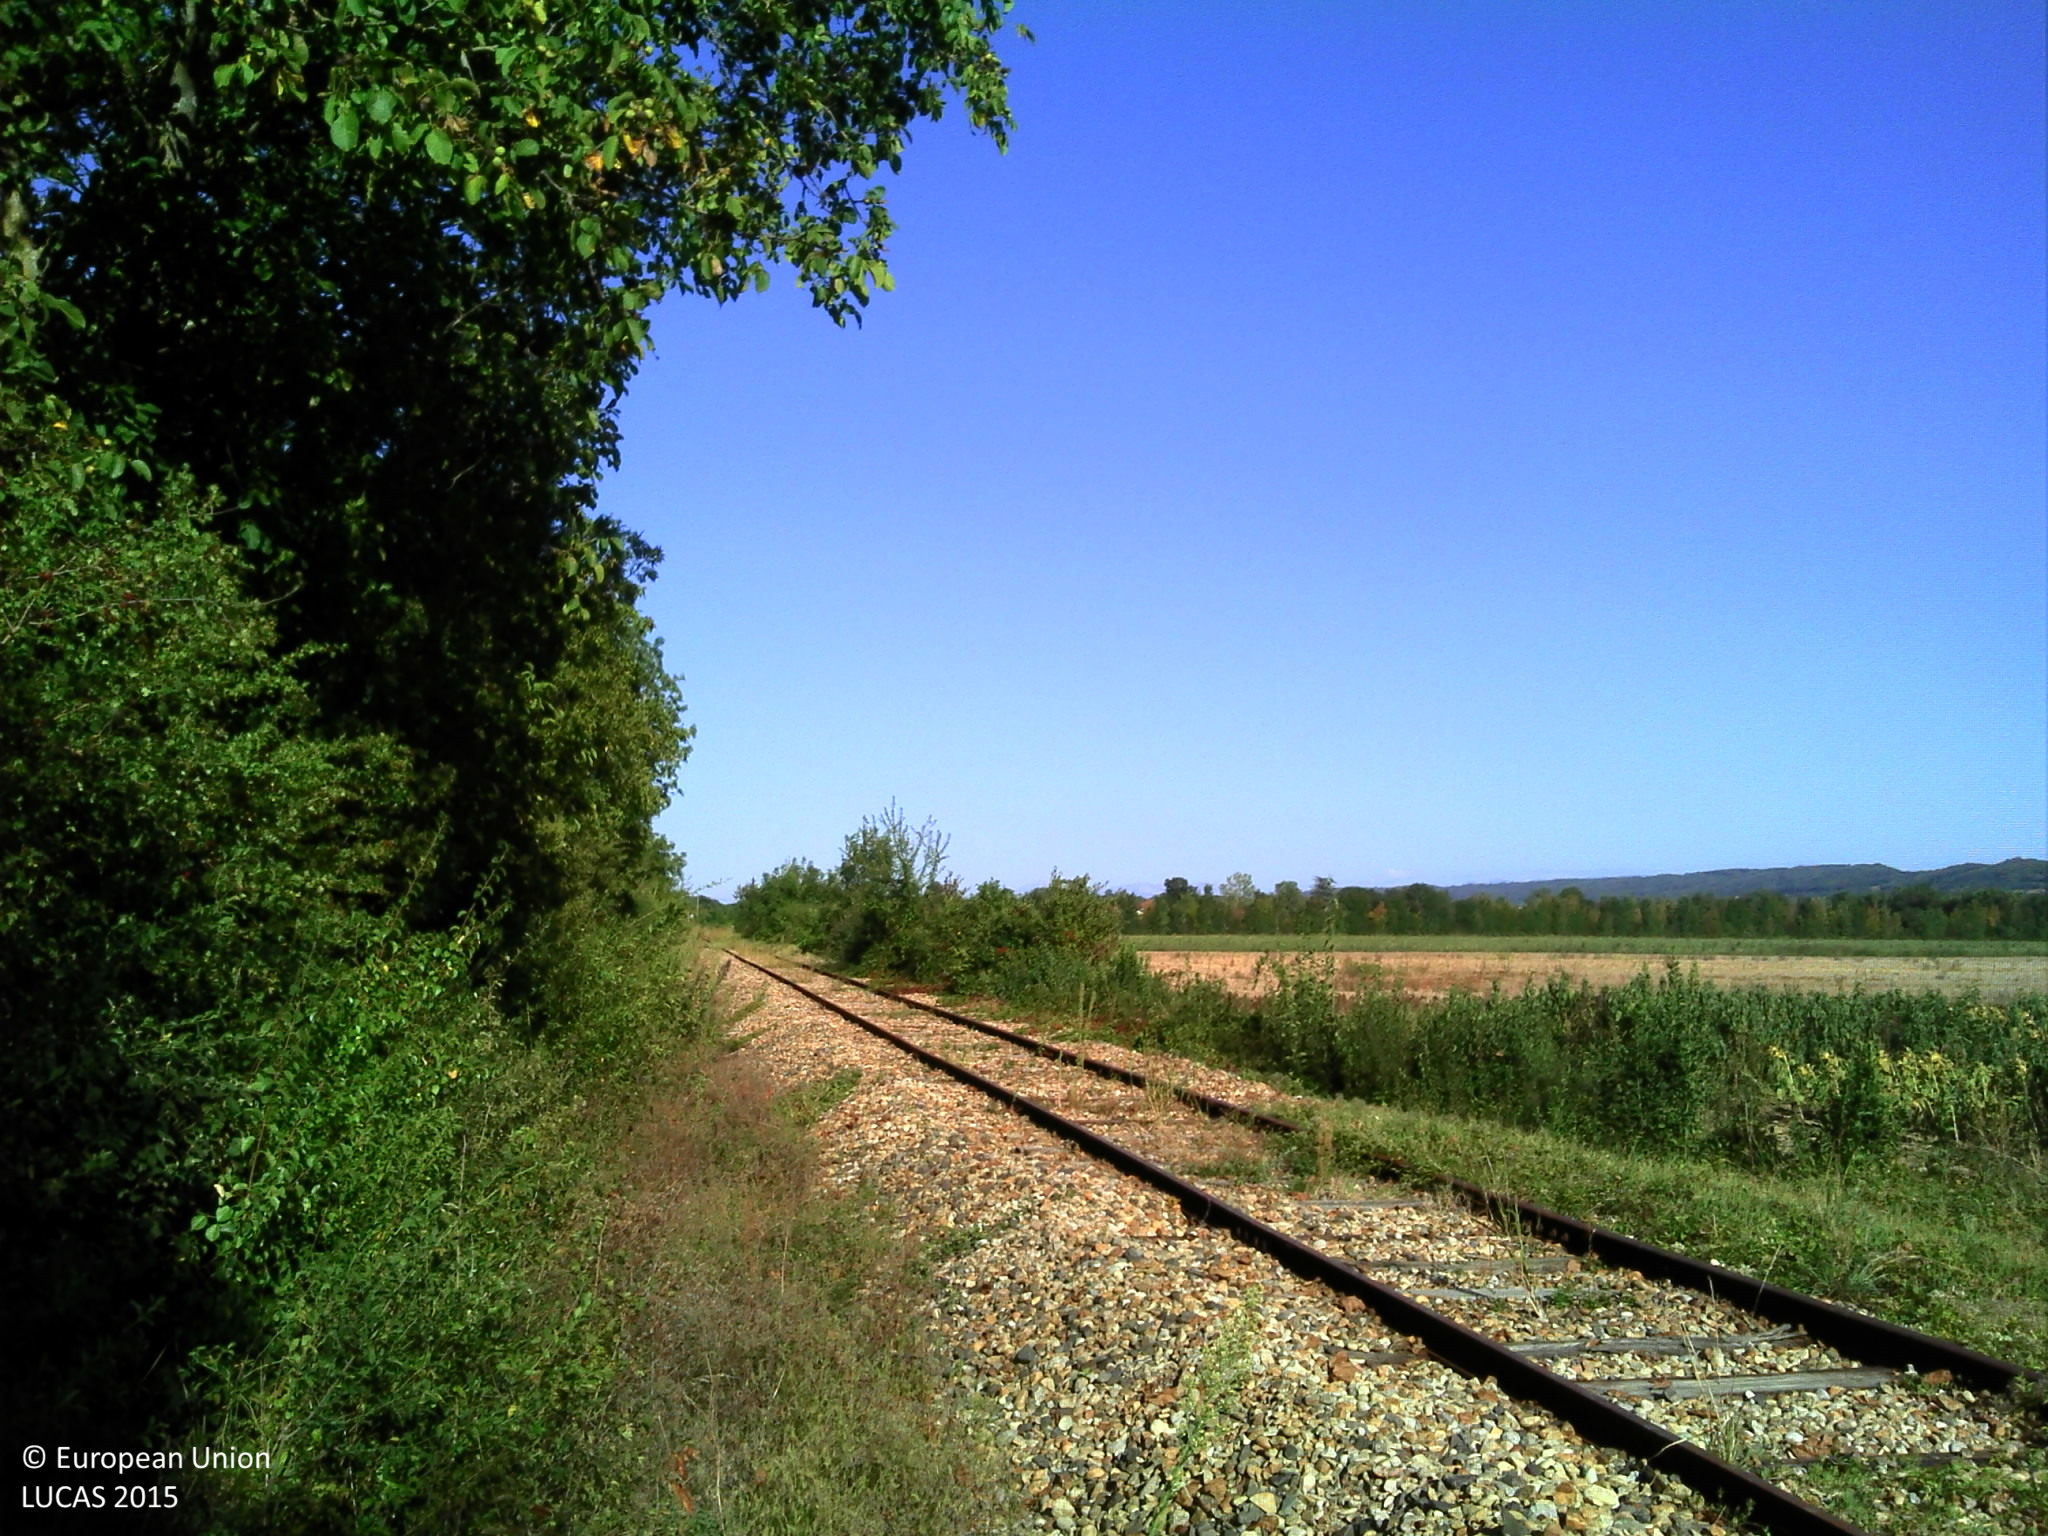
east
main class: Woodland
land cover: Broadleaved woodland
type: mesophytic deciduous forest
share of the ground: > 75 %
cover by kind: broadleaved forest trees 85 %, shrubs 10 %, coniferous forest trees 5 %
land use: Semi-natural and natural areas not in use
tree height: > 5 m
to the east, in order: Broadleaved woodland; Railways; Ditches and canals; Sunflower; Common wheat; Maize
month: September
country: FR
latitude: 45.3134
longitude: 4.9919
